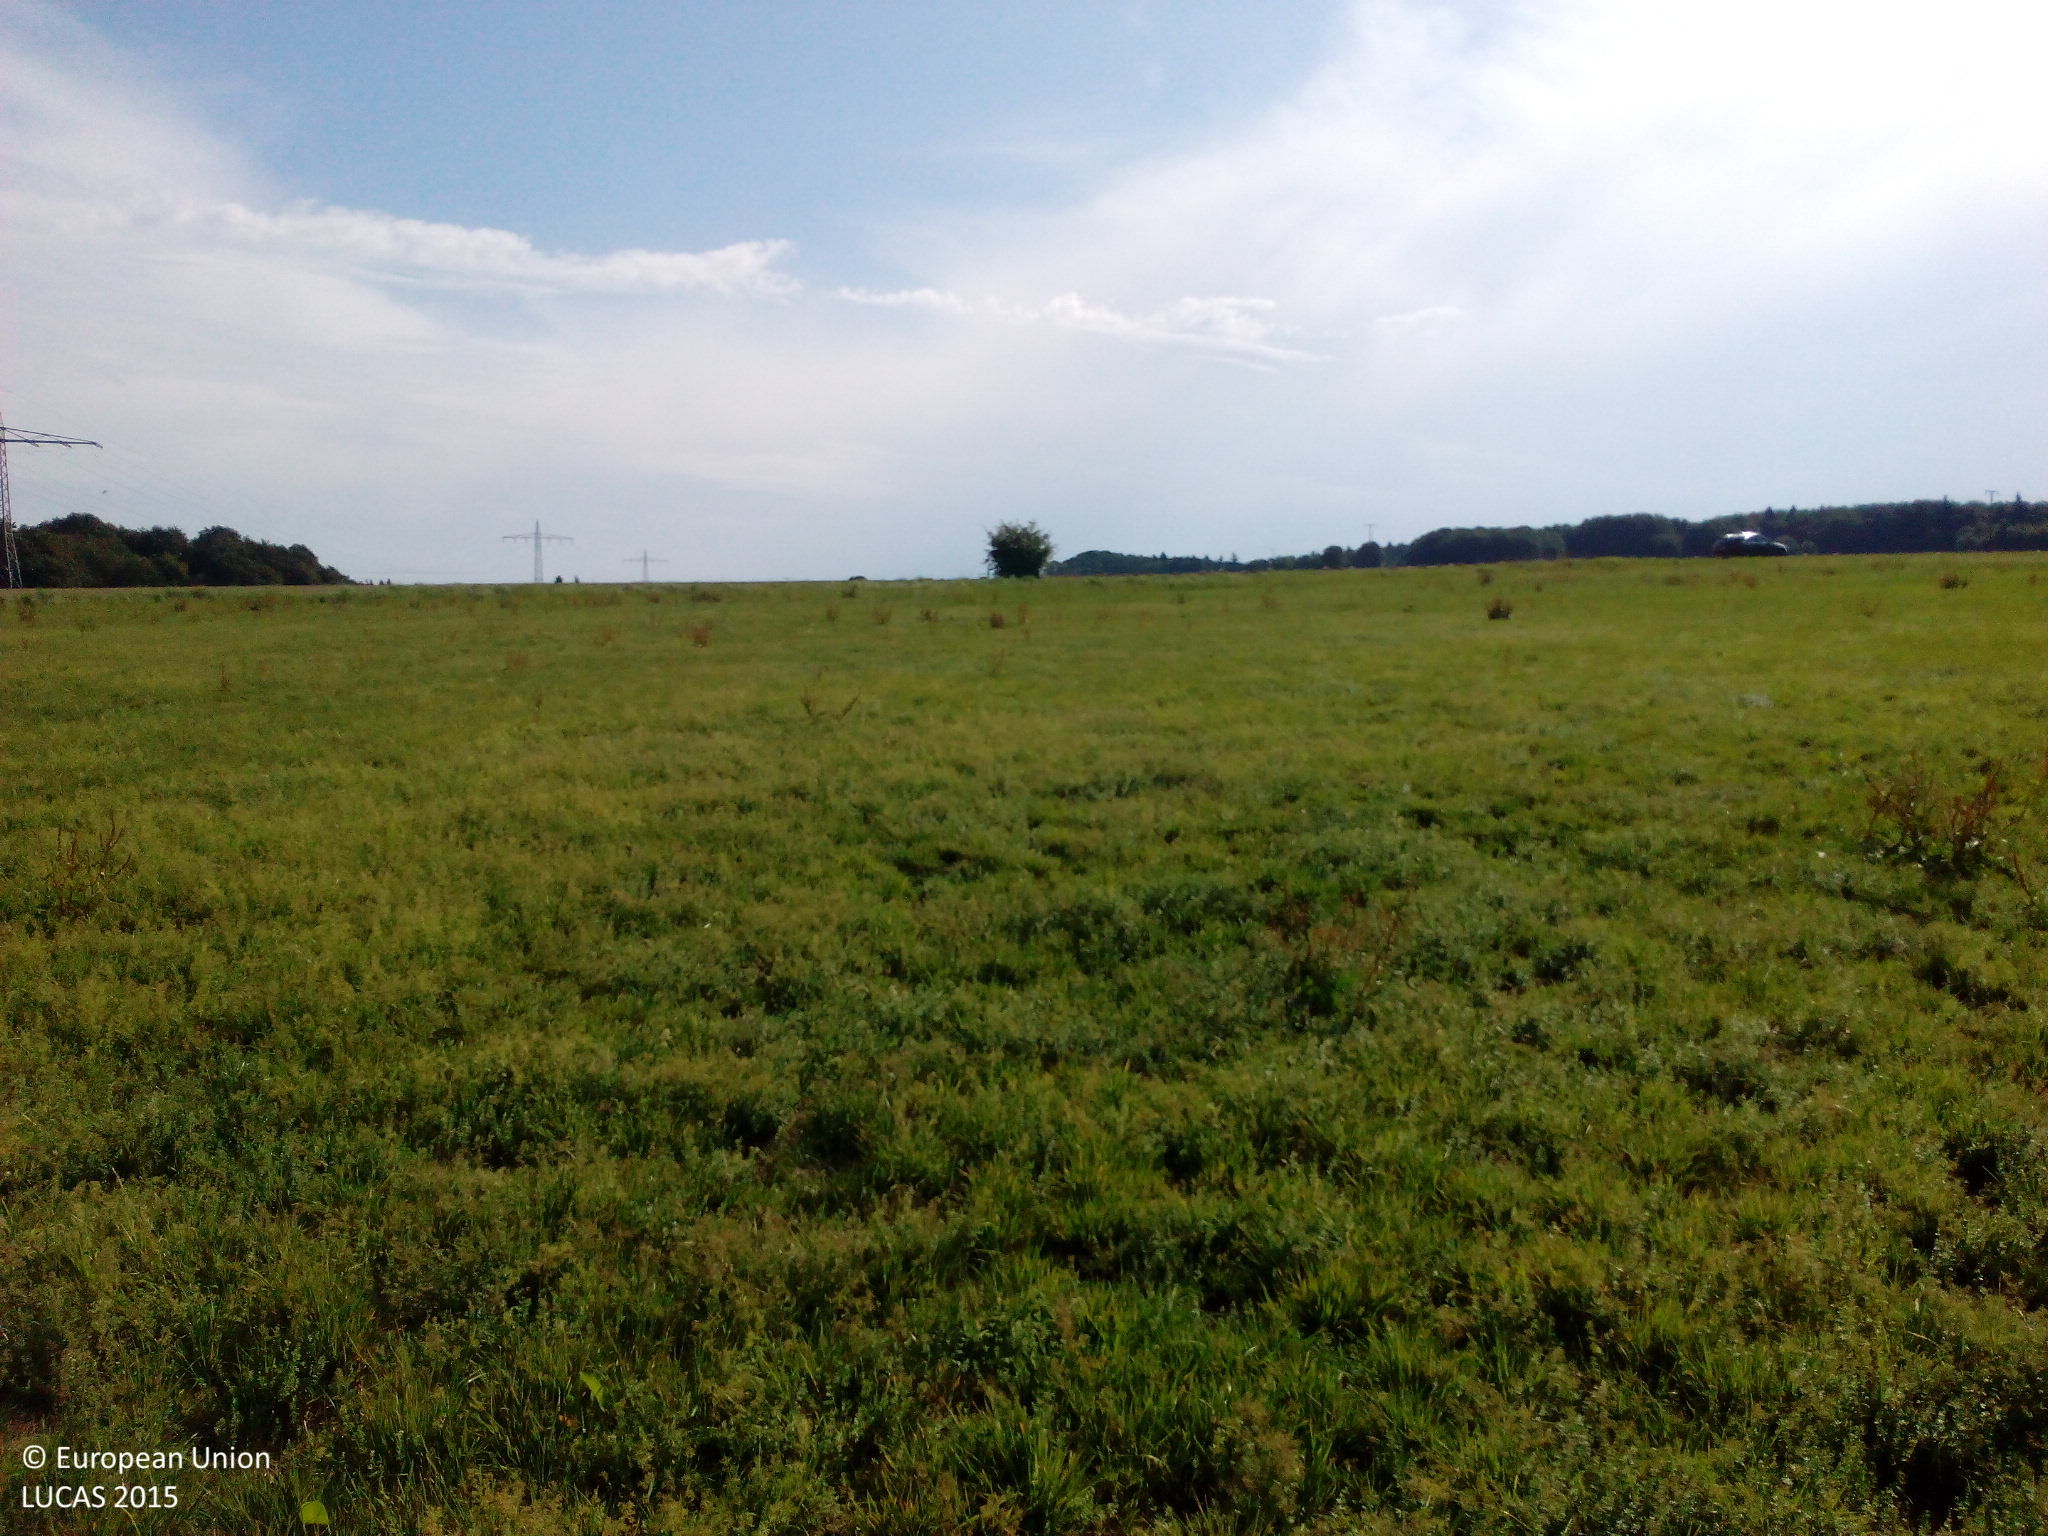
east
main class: Grassland
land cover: Grassland without tree/shrub cover
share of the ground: > 75 %
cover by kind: herbaceous plants 90 %, unconsolidated bare surface 10 %
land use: Agriculture (excluding fallow land and kitchen gardens)
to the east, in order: Grassland without tree/shrub cover; Paved roads, cycling and walking lanes; Grass margins; Common wheat
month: August
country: DE
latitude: 50.2652
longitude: 7.5172
